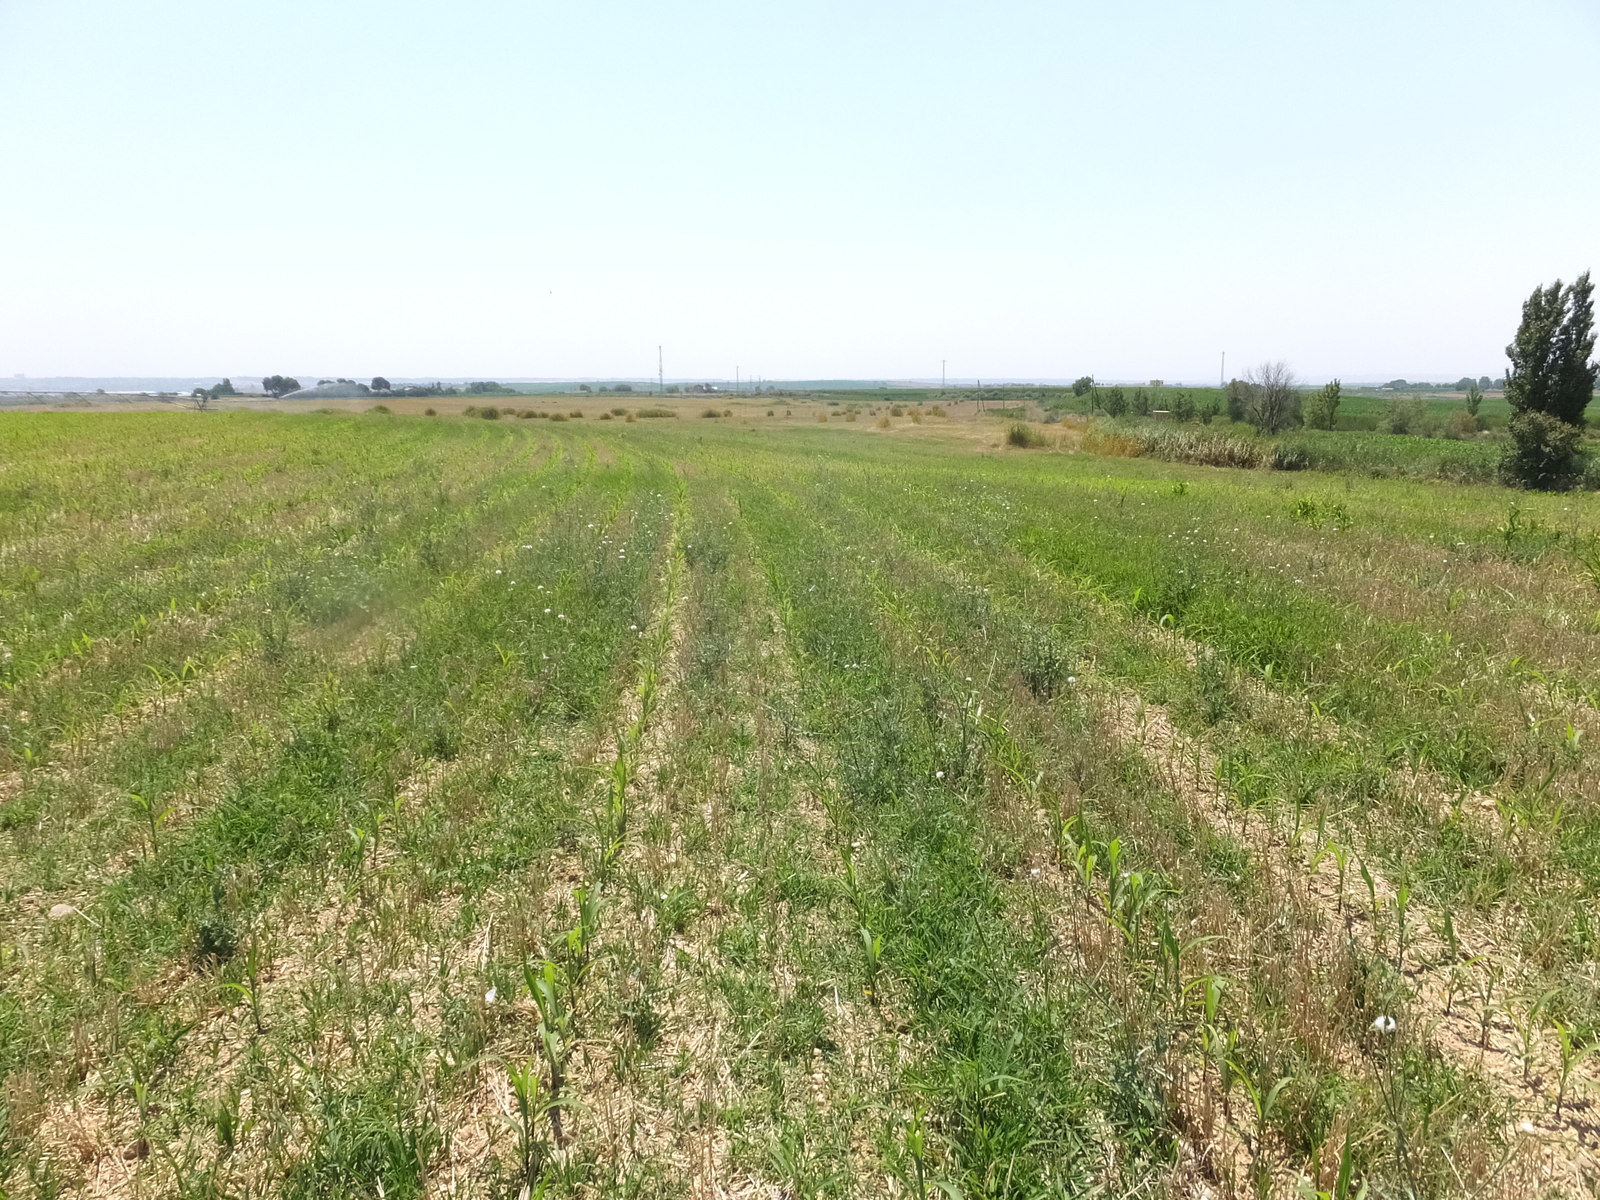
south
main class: Cropland
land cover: Maize
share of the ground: < 10 %
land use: Agriculture (excluding fallow land and kitchen gardens)
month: June
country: ES
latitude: 41.7919
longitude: 0.3459
